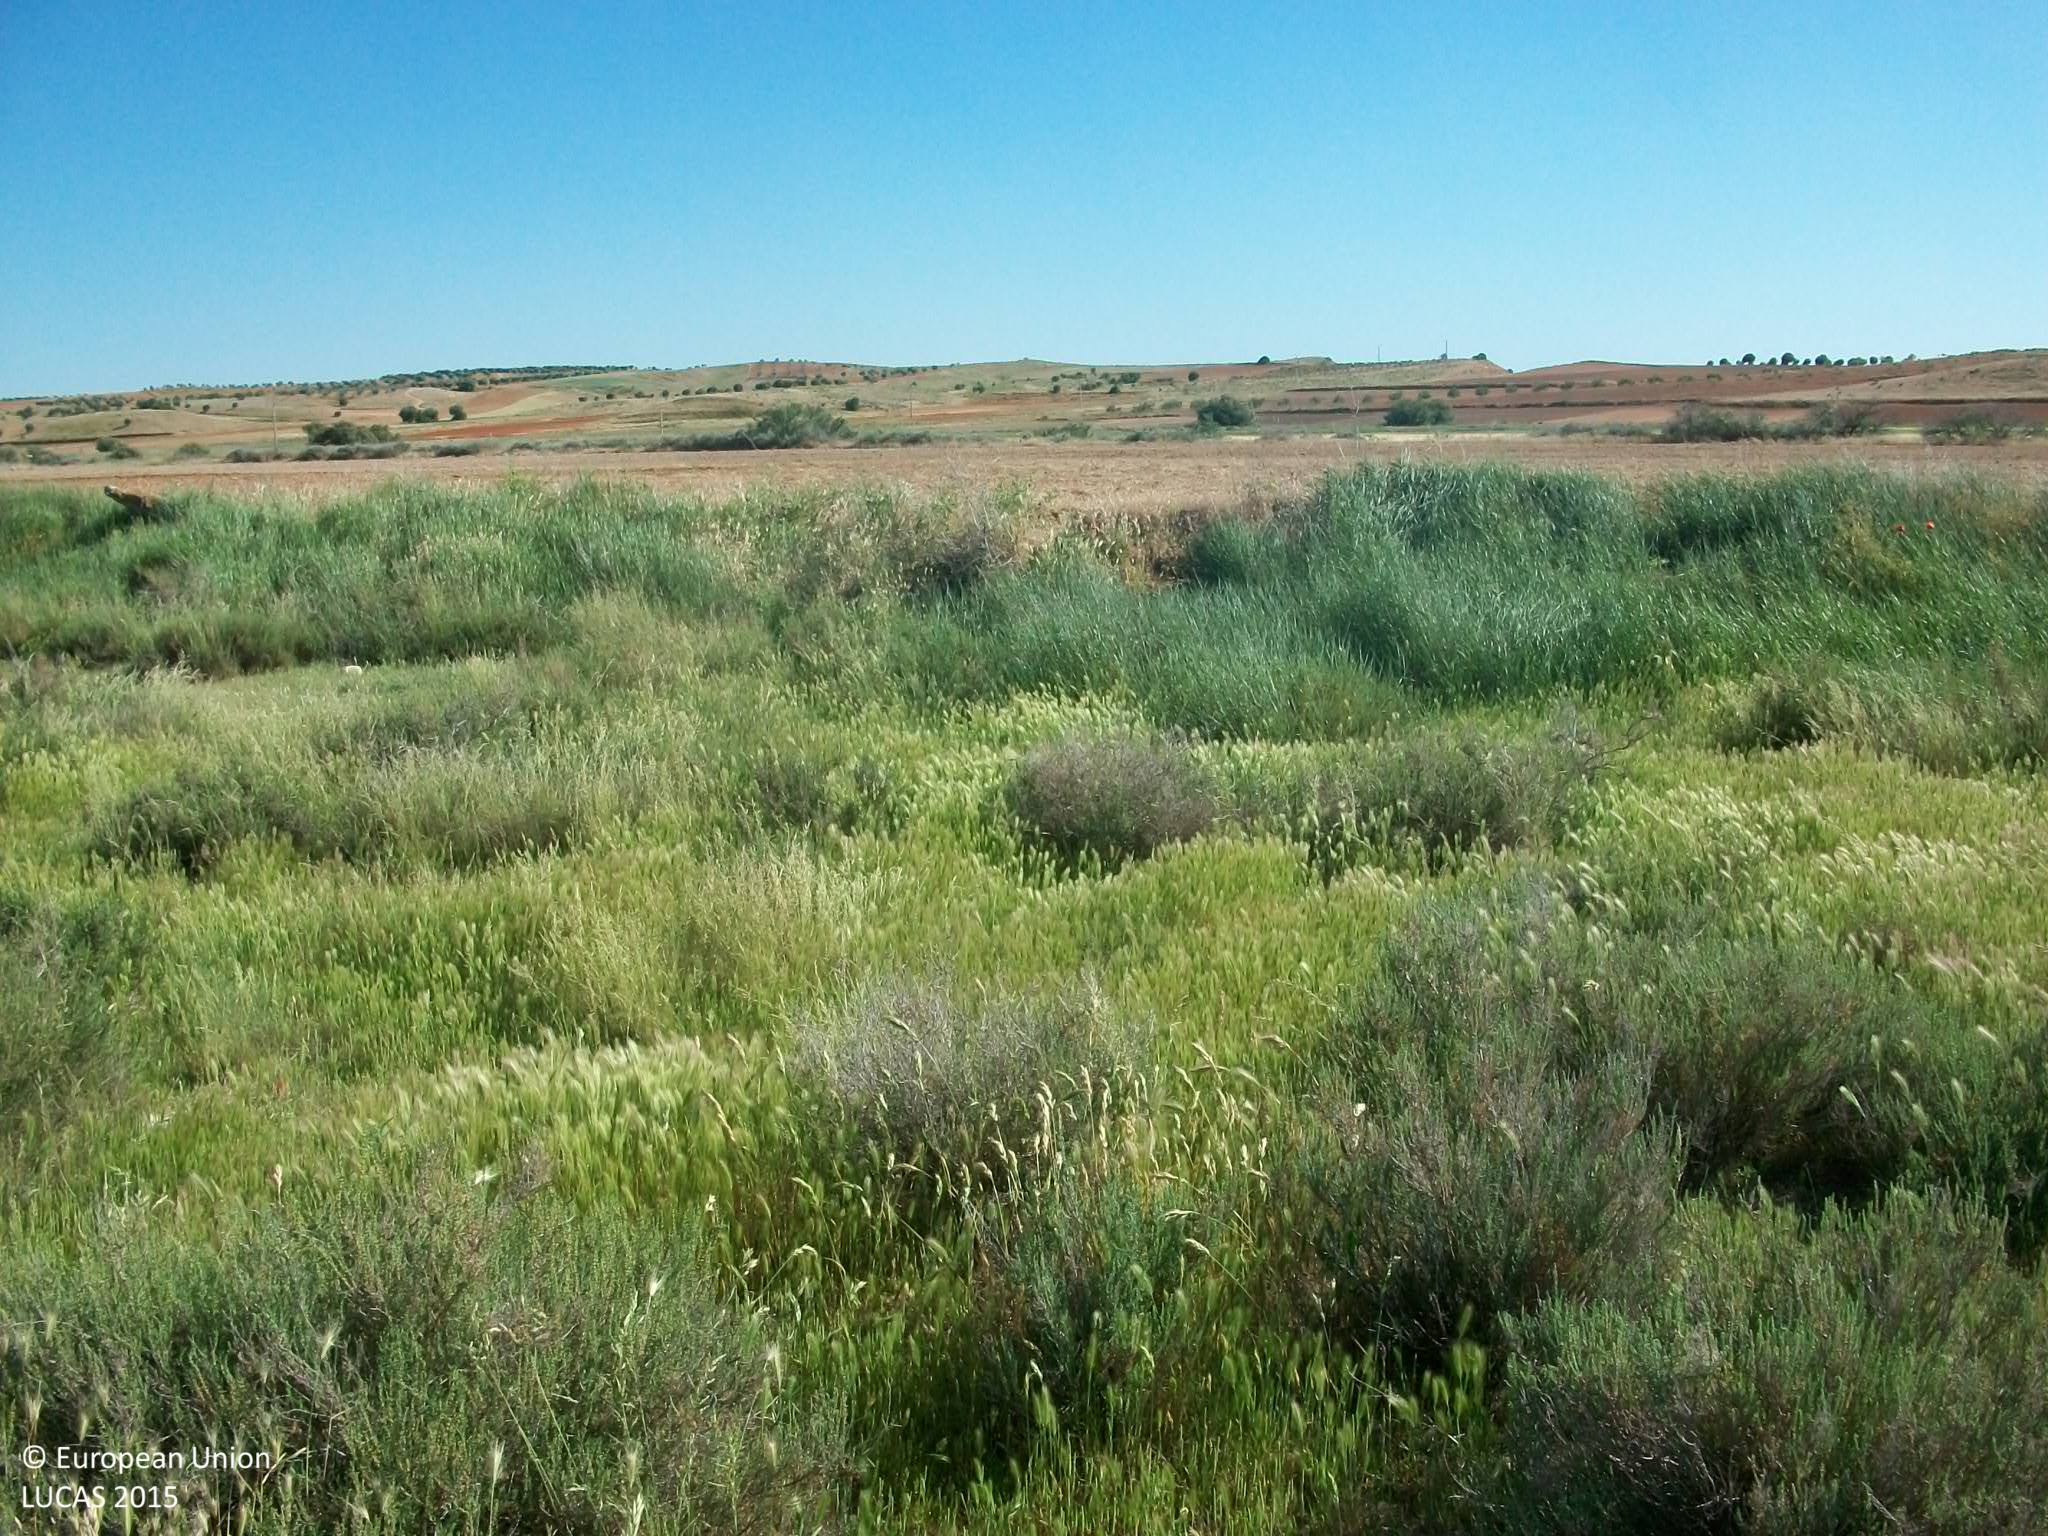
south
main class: Grassland
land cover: Spontaneously vegetated surfaces
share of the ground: > 75 %
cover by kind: herbaceous plants 90 %, unconsolidated bare surface 10 %
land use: Semi-natural and natural areas not in use
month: May
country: ES
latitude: 39.8406
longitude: -3.6435
